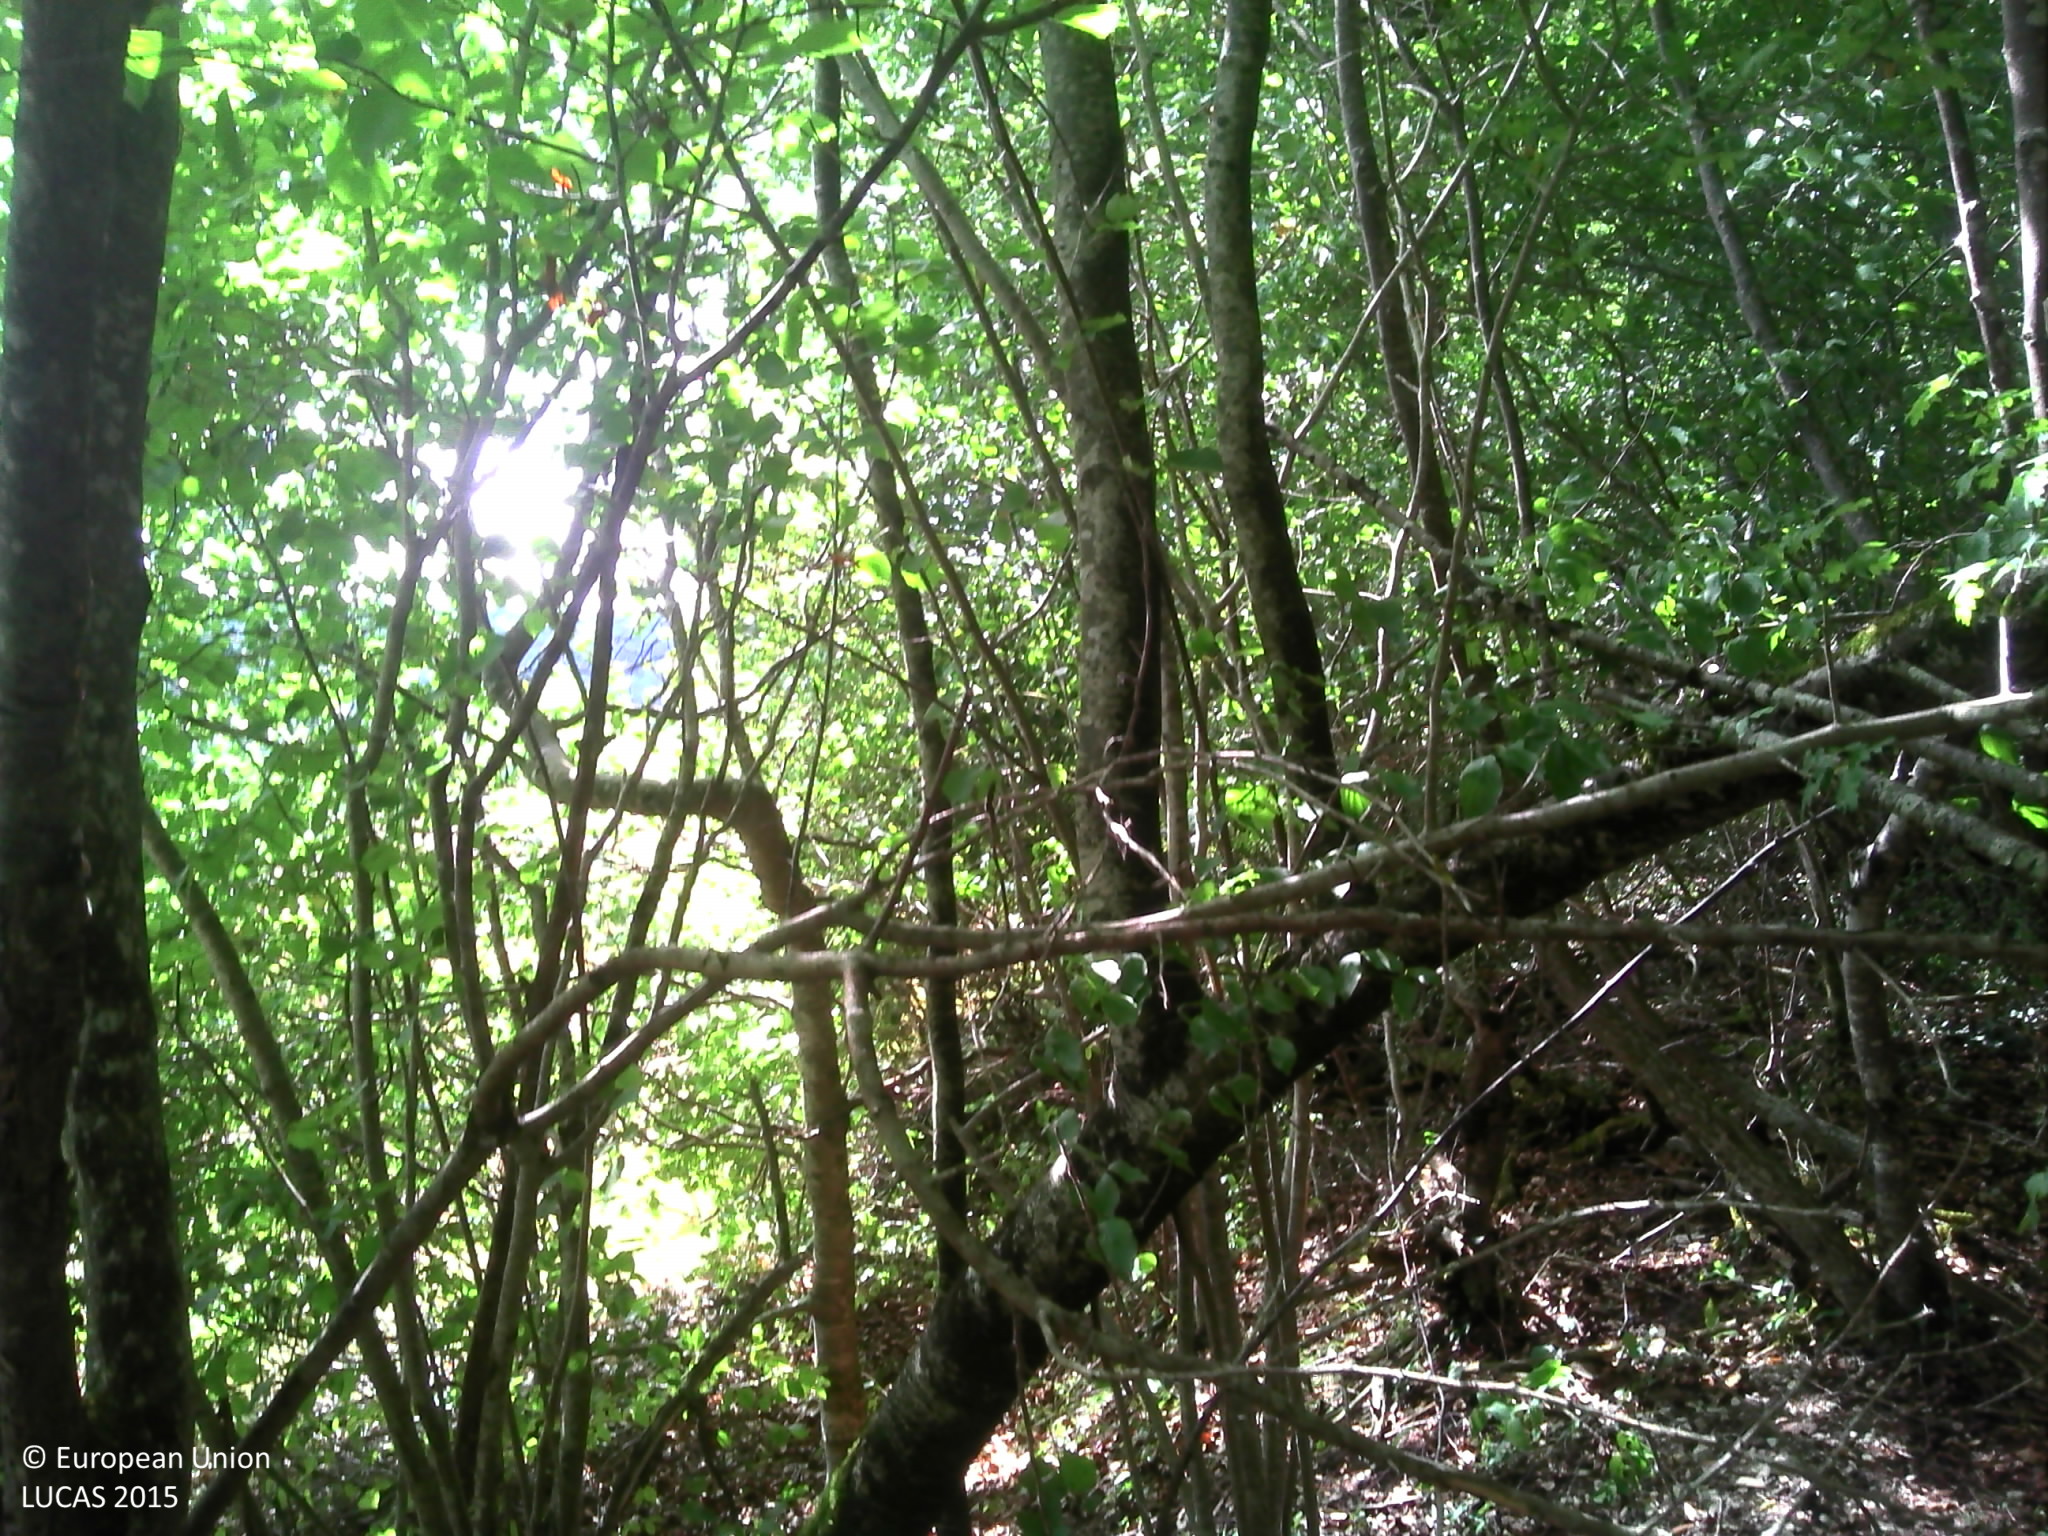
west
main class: Woodland
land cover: Broadleaved woodland
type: acidophilous oak and oak-birch forest
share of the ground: > 75 %
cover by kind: broadleaved forest trees 85 %, coniferous forest trees 5 %, herbaceous plants 5 %, lichens and mosses 5 %
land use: Forestry
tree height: > 5 m
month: July
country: FR
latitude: 47.8918
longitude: 4.9570
